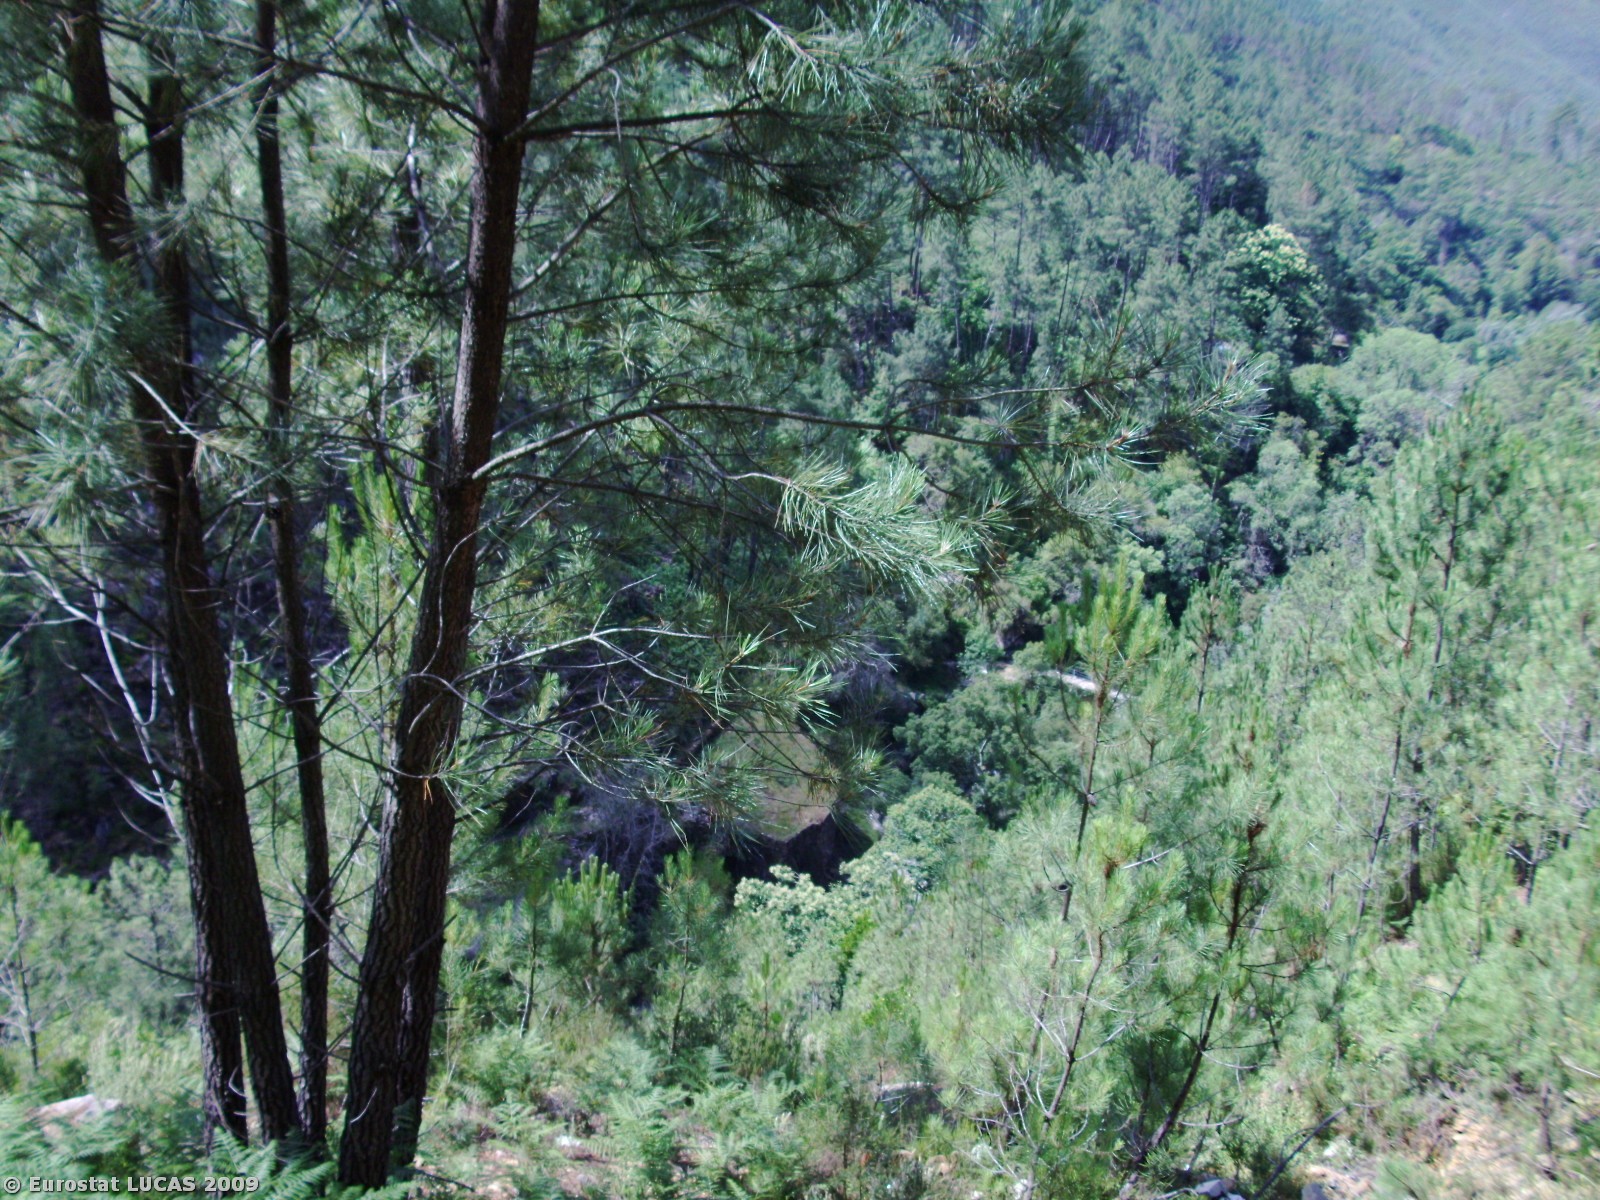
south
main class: Woodland
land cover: Coniferous woodland
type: coniferous forest of the mediterranean region
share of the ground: 50 - 75 %
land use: Forestry
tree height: > 5 m
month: June
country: PT
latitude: 40.3183
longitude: -7.7305
